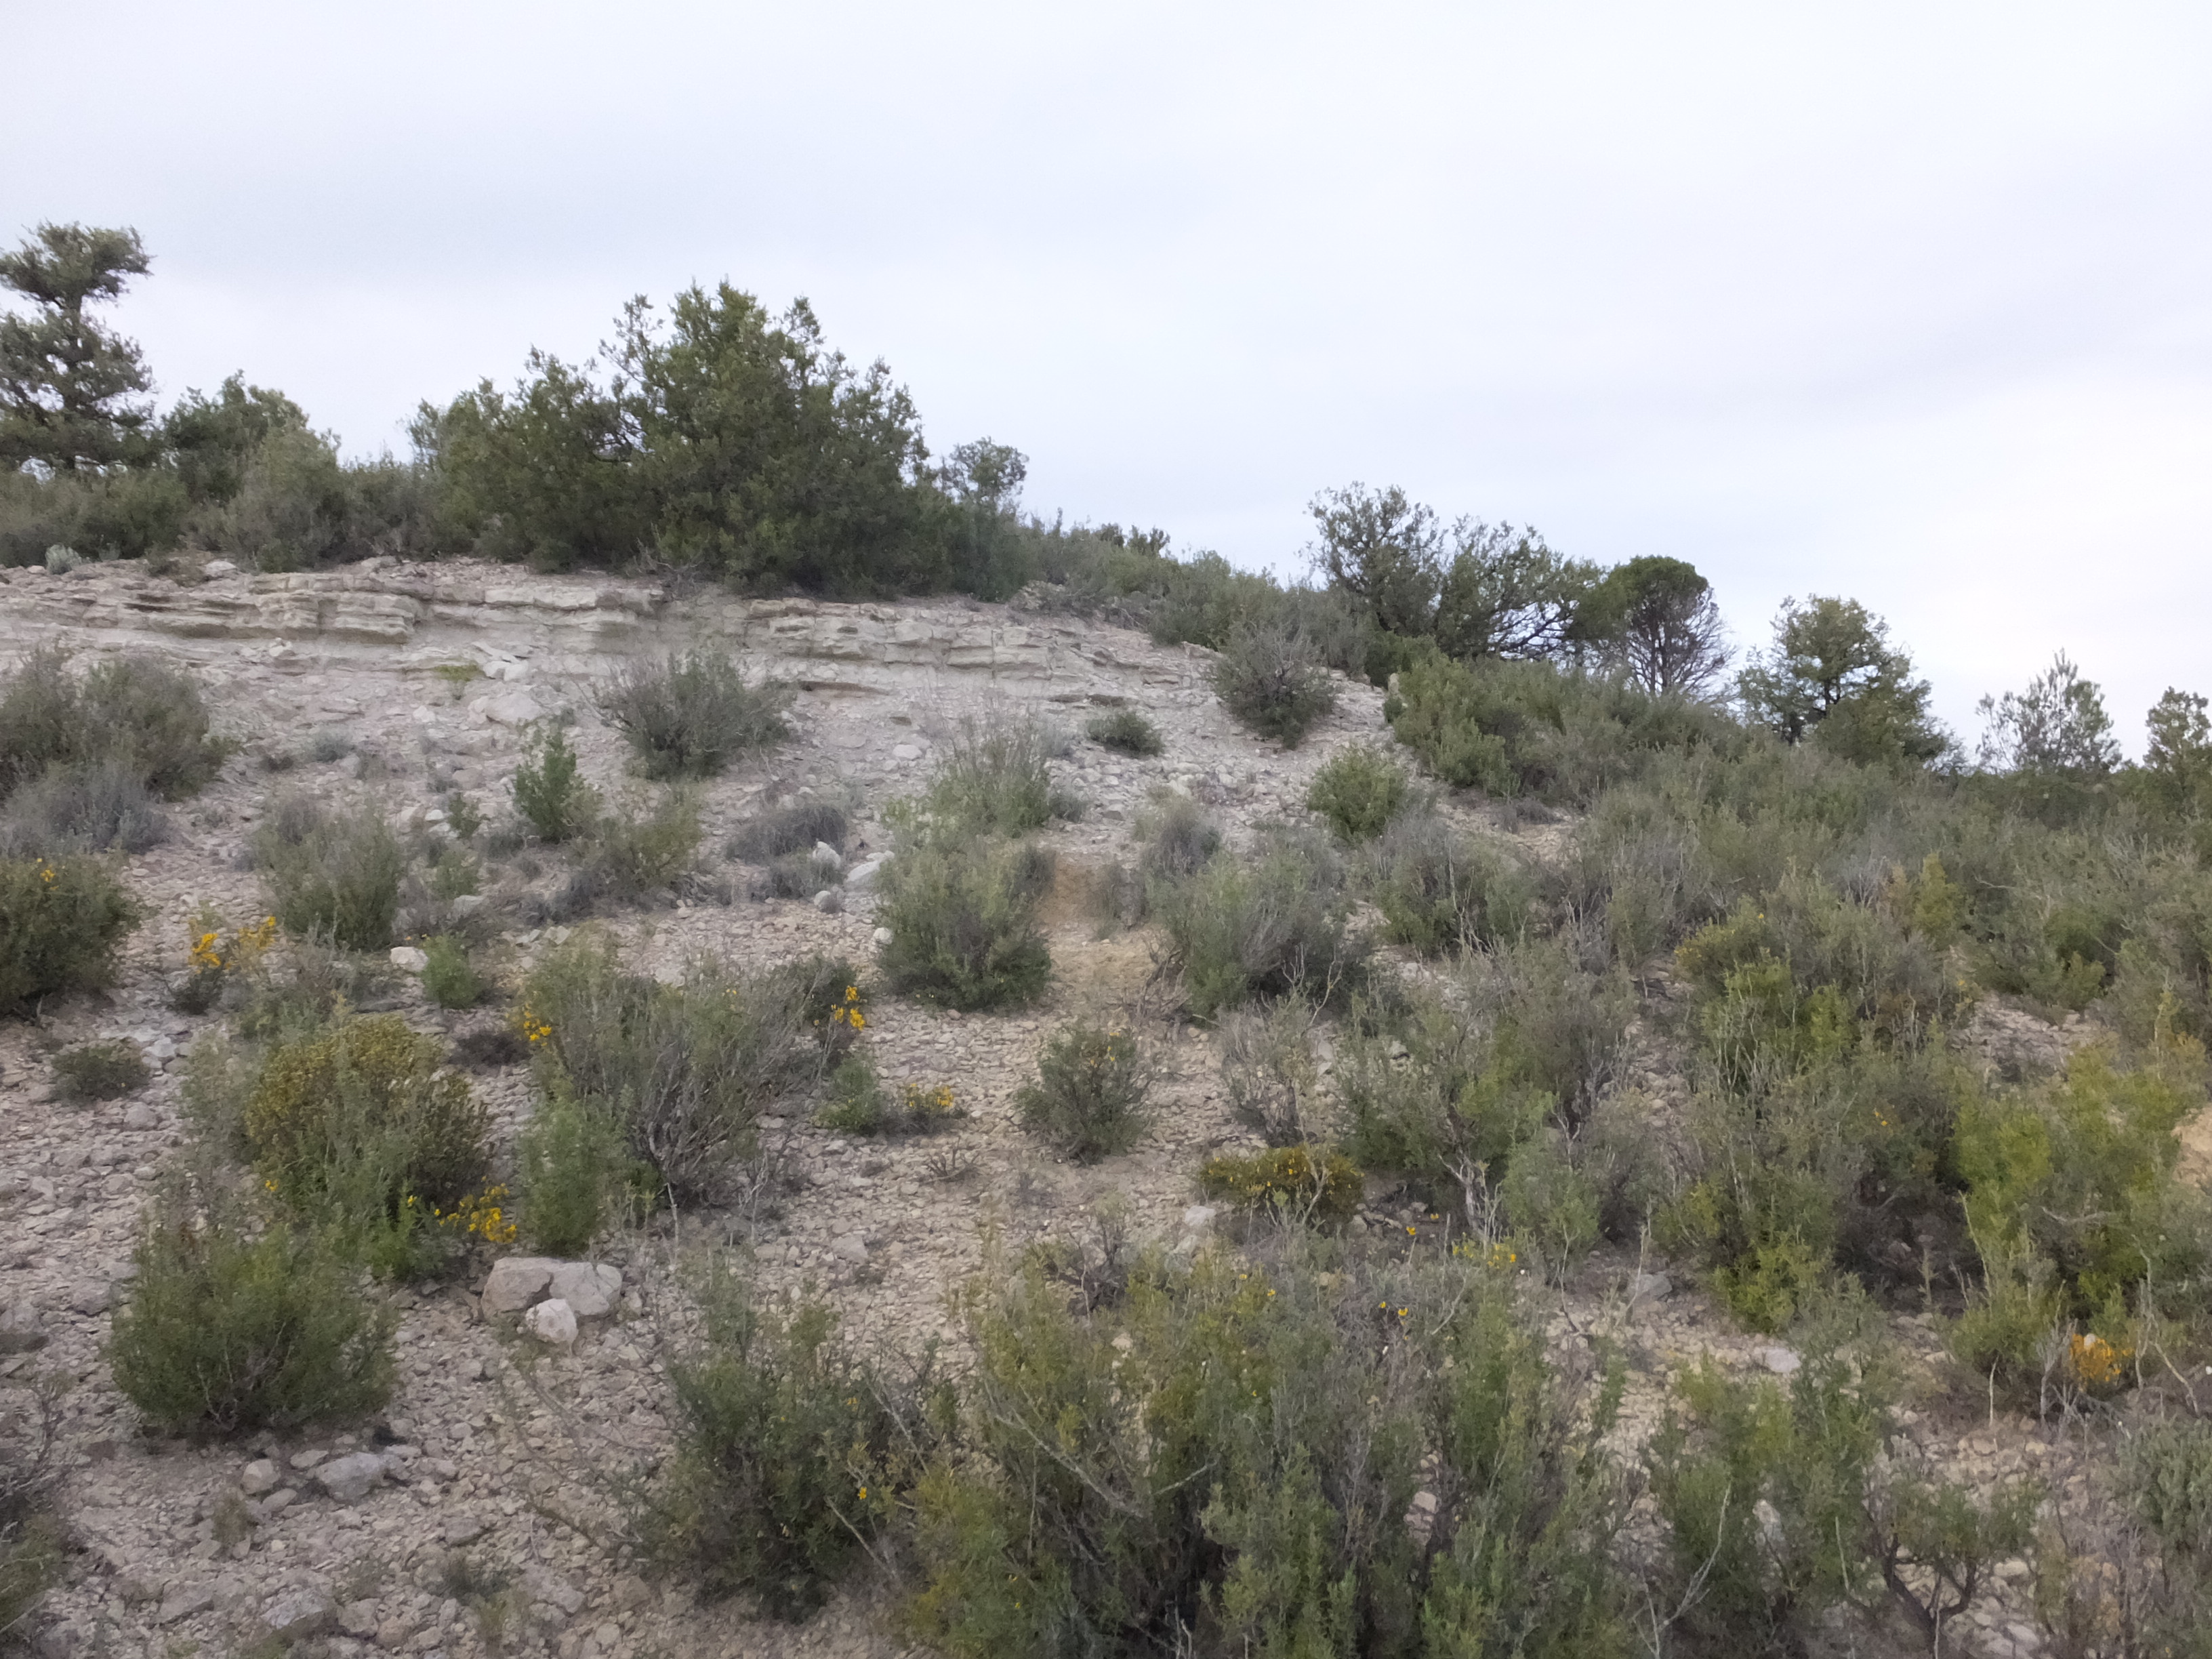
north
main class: Shrubland
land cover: Shrubland with sparse tree cover
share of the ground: > 75 %
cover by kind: shrubs 75 %, herbaceous plants 20 %, coniferous forest trees 5 %
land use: Semi-natural and natural areas not in use
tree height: > 5 m
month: April
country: ES
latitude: 41.6715
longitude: -0.3115
